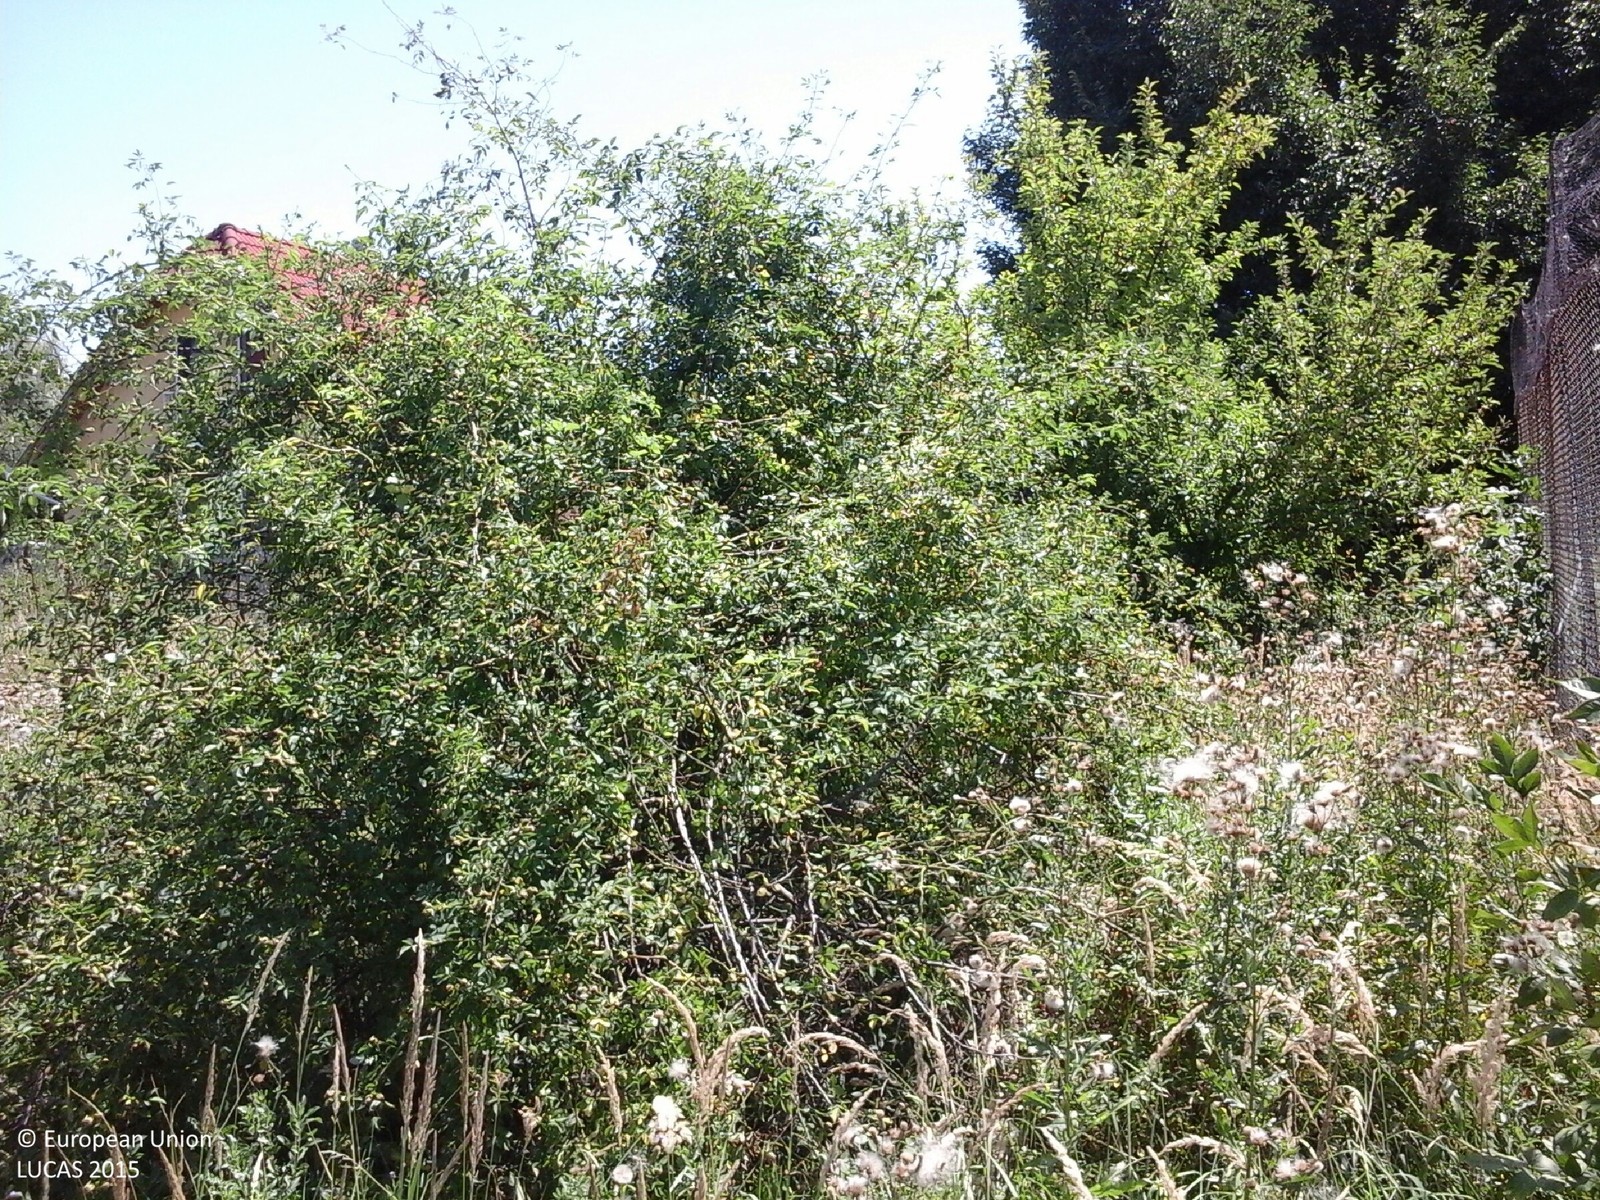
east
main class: Grassland
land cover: Grassland with sparse tree/shrub cover
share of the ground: > 75 %
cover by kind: herbaceous plants 90 %, broadleaved forest trees 5 %, shrubs 5 %
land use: Residential
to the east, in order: Grassland with sparse tree/shrub cover; Artificial constructions in urban areas
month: July
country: HU
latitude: 47.5837
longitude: 20.6031
